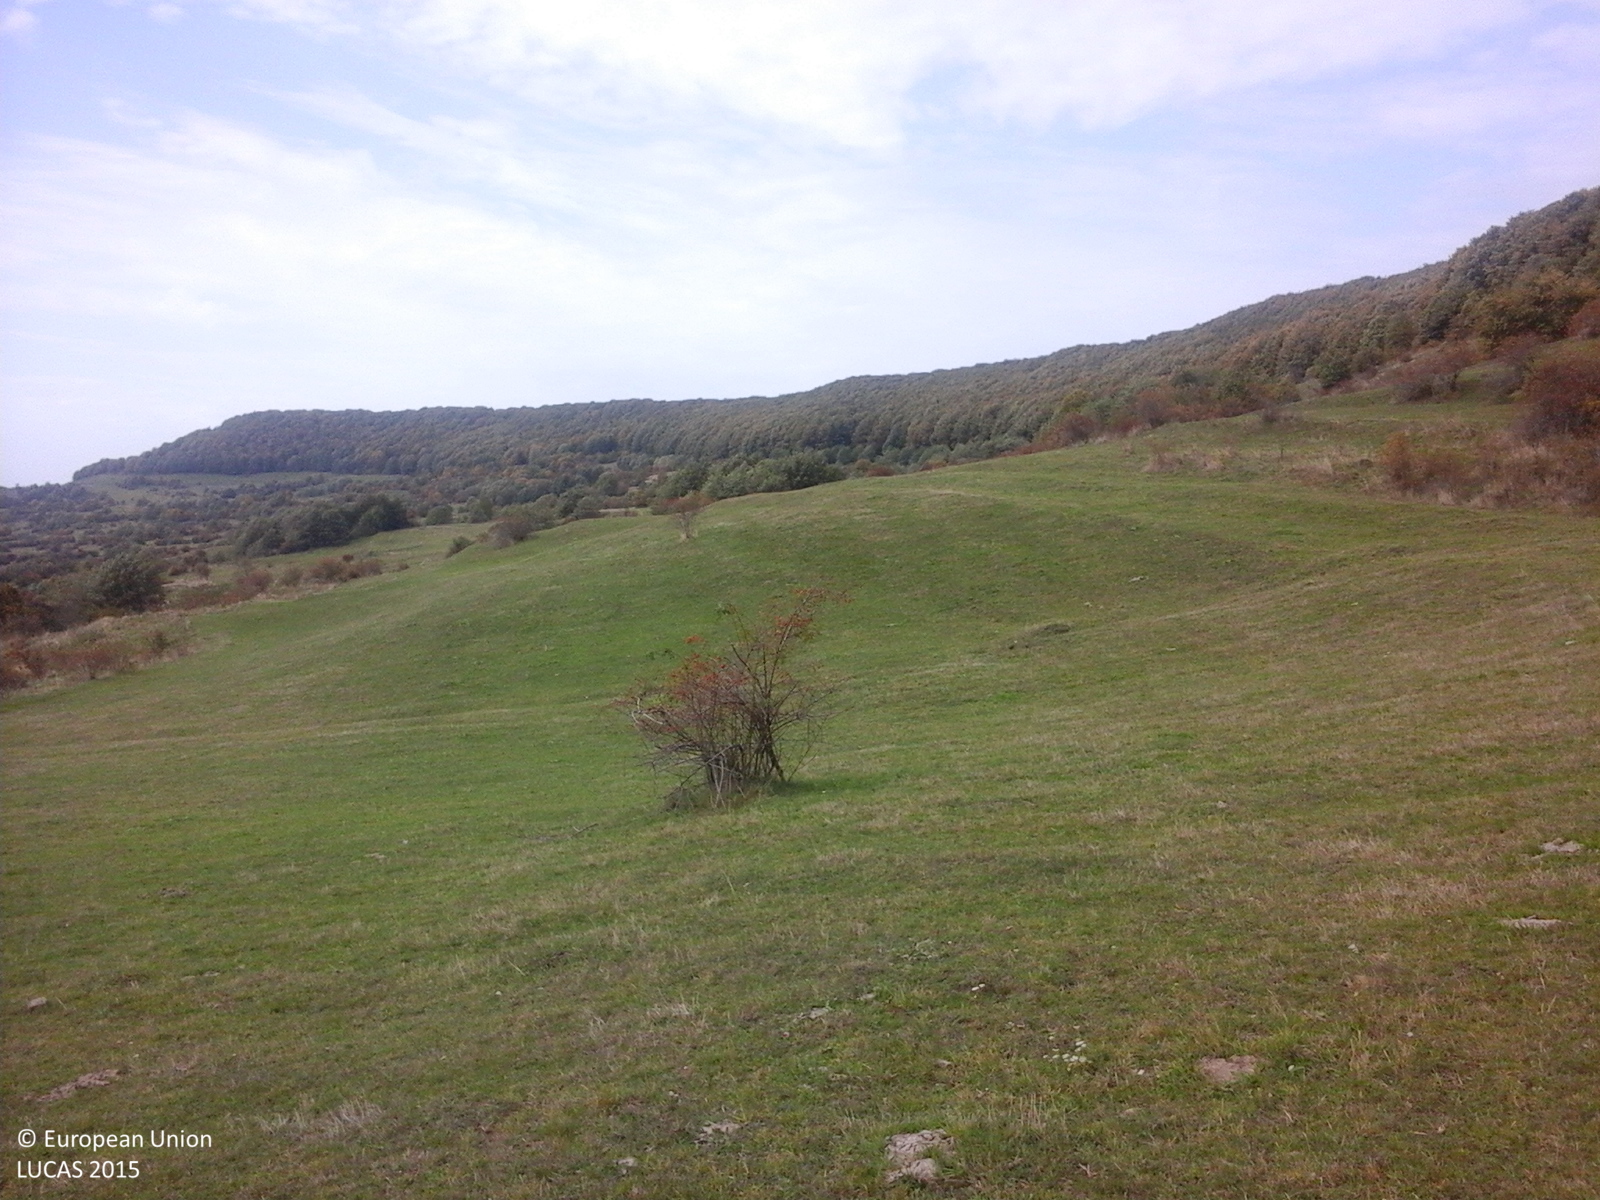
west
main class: Grassland
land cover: Grassland without tree/shrub cover
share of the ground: > 75 %
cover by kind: herbaceous plants 100 %
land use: Agriculture (excluding fallow land and kitchen gardens)
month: October
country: RO
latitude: 46.3991
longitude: 25.2813
